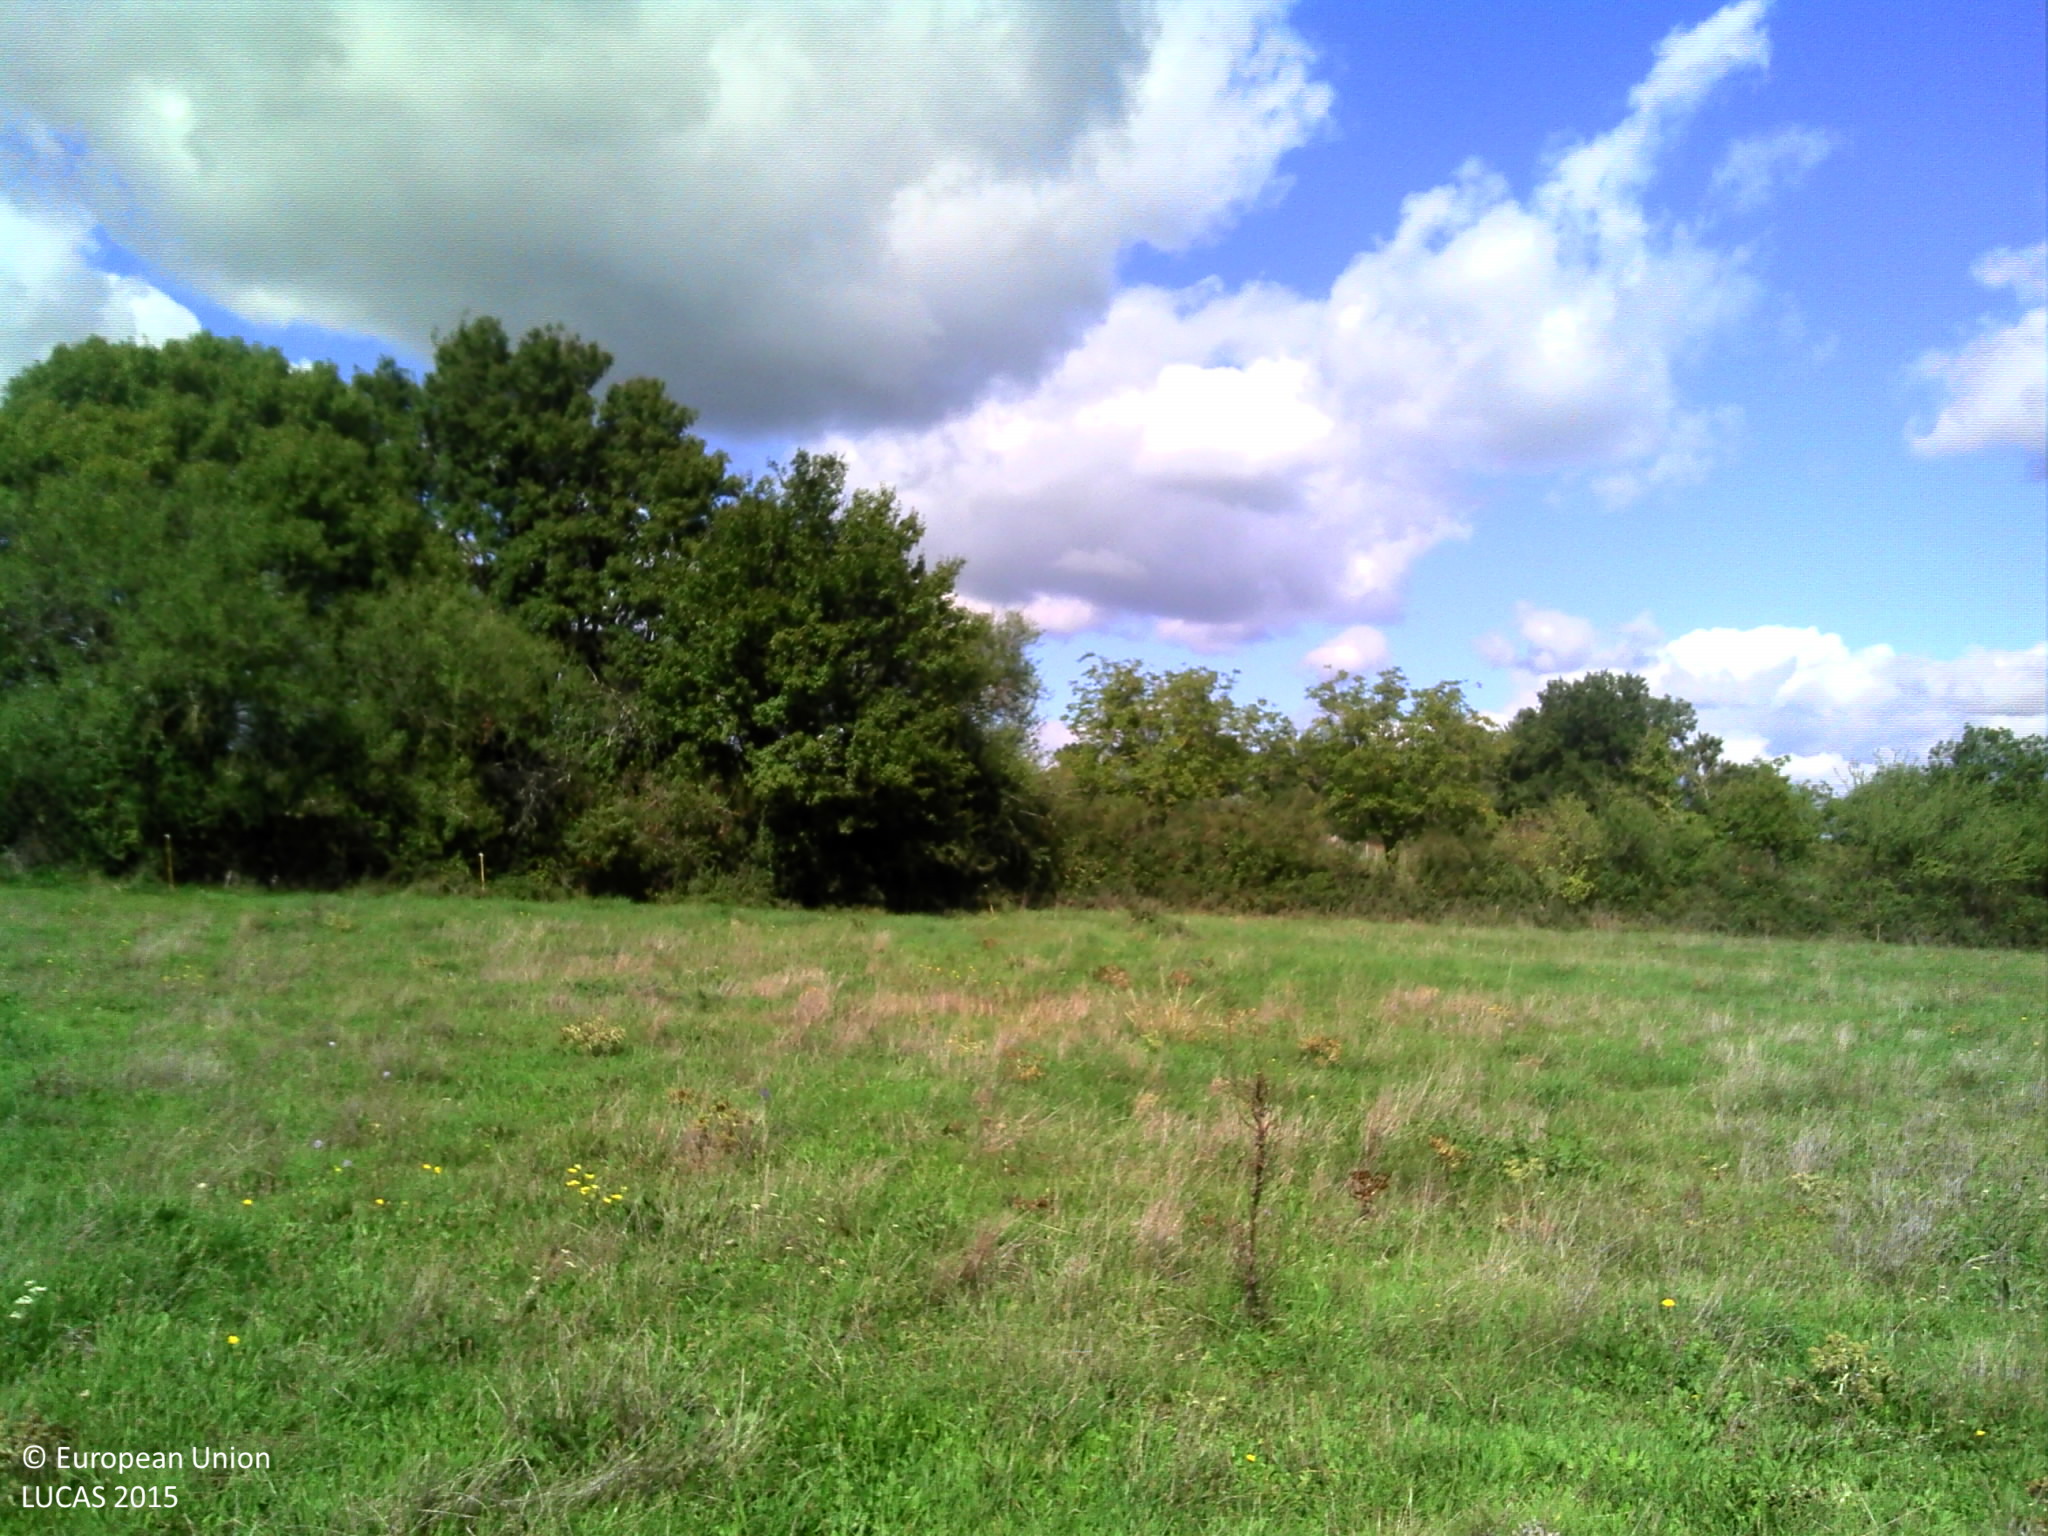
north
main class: Grassland
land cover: Grassland without tree/shrub cover
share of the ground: > 75 %
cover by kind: herbaceous plants 100 %
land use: Agriculture (excluding fallow land and kitchen gardens)
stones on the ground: < 10 %
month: September
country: FR
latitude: 44.7664
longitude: 1.7732
